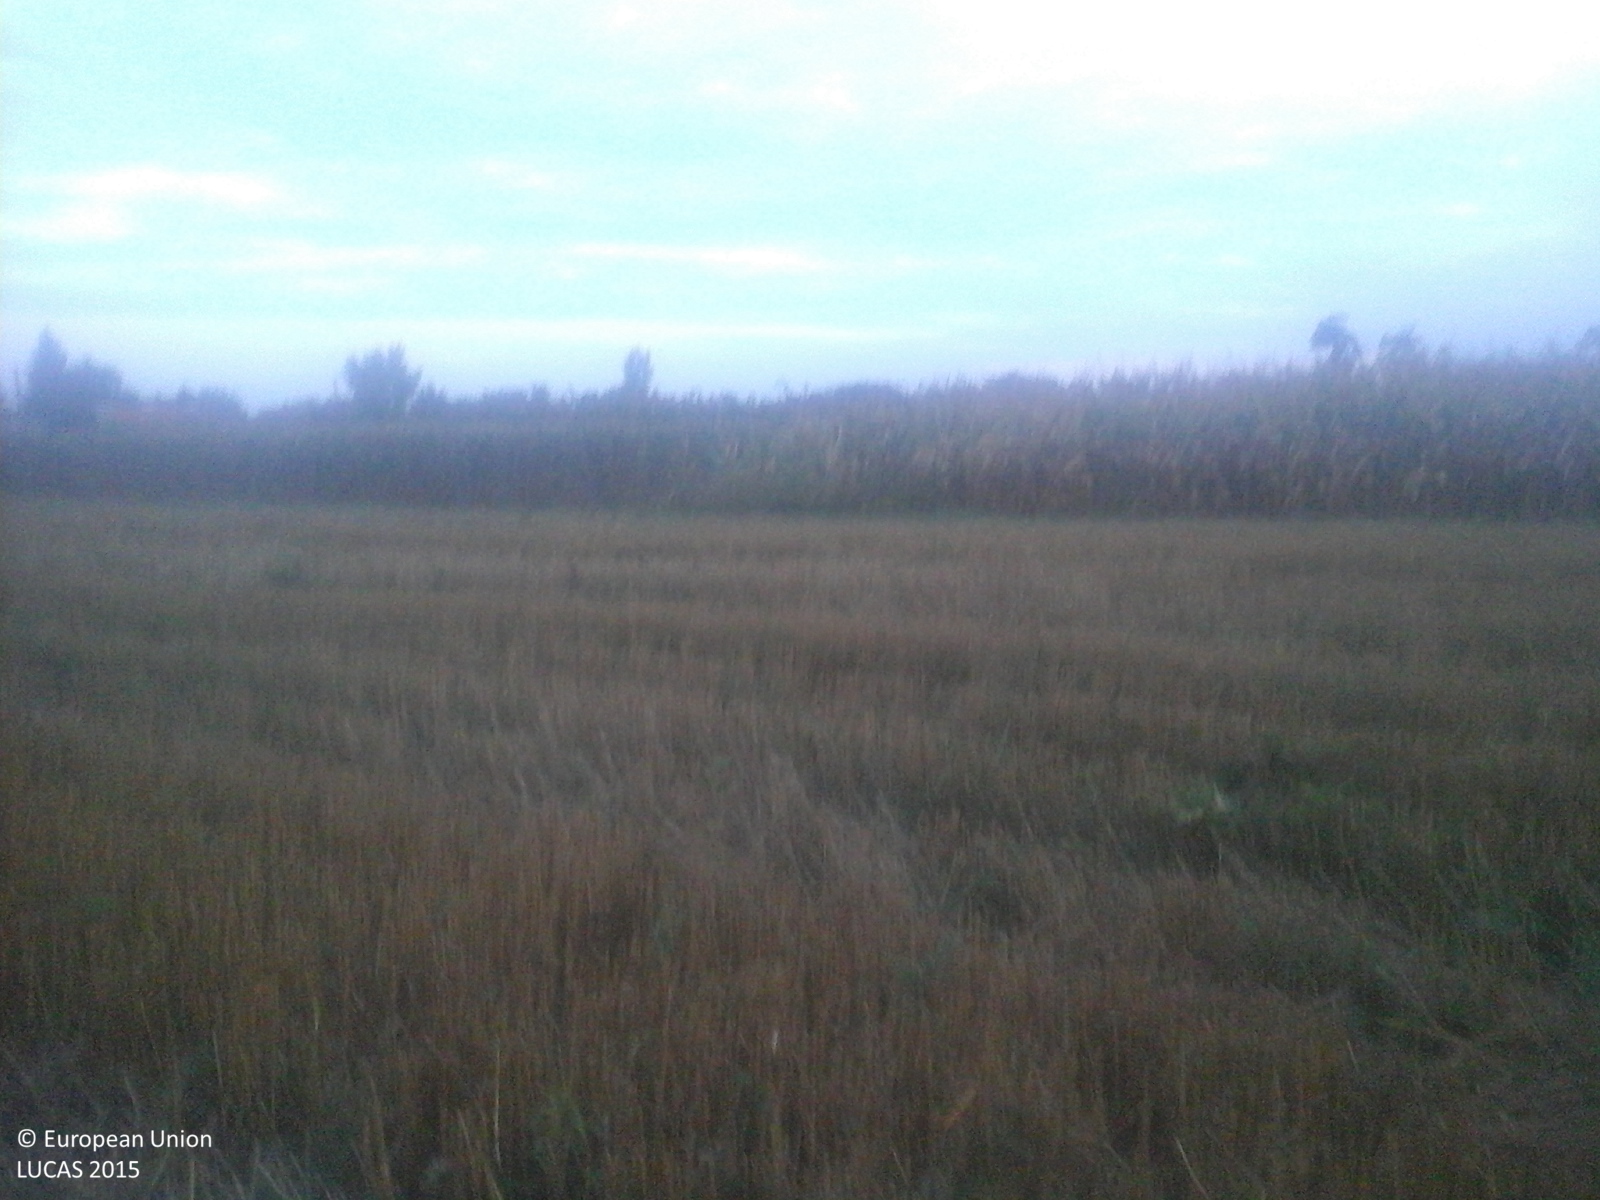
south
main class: Cropland
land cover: Durum wheat
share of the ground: > 75 %
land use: Agriculture (excluding fallow land and kitchen gardens)
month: September
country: RO
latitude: 47.8123
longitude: 22.7085
